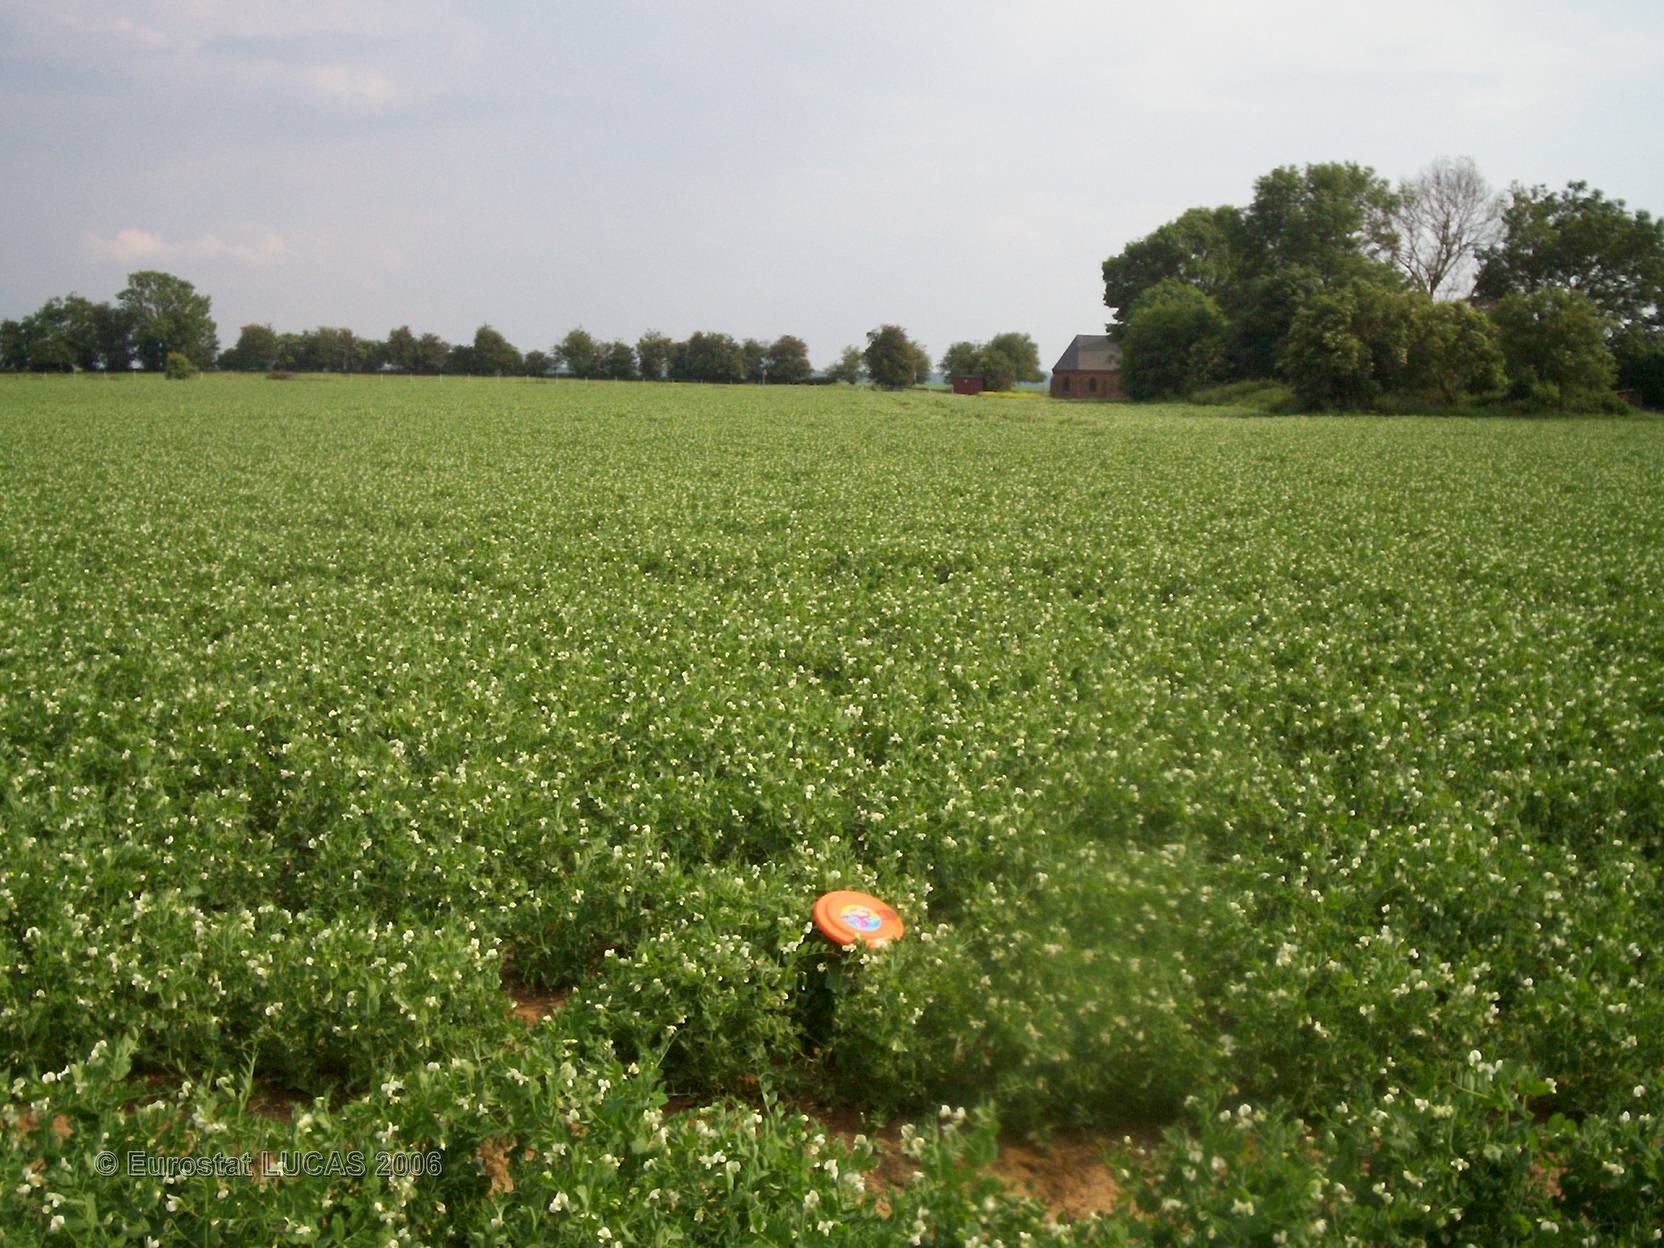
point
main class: Cropland
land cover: Other fresh vegetables
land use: Agriculture (excluding fallow land and kitchen gardens)
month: June
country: FR
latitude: 49.6801
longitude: 2.7130
